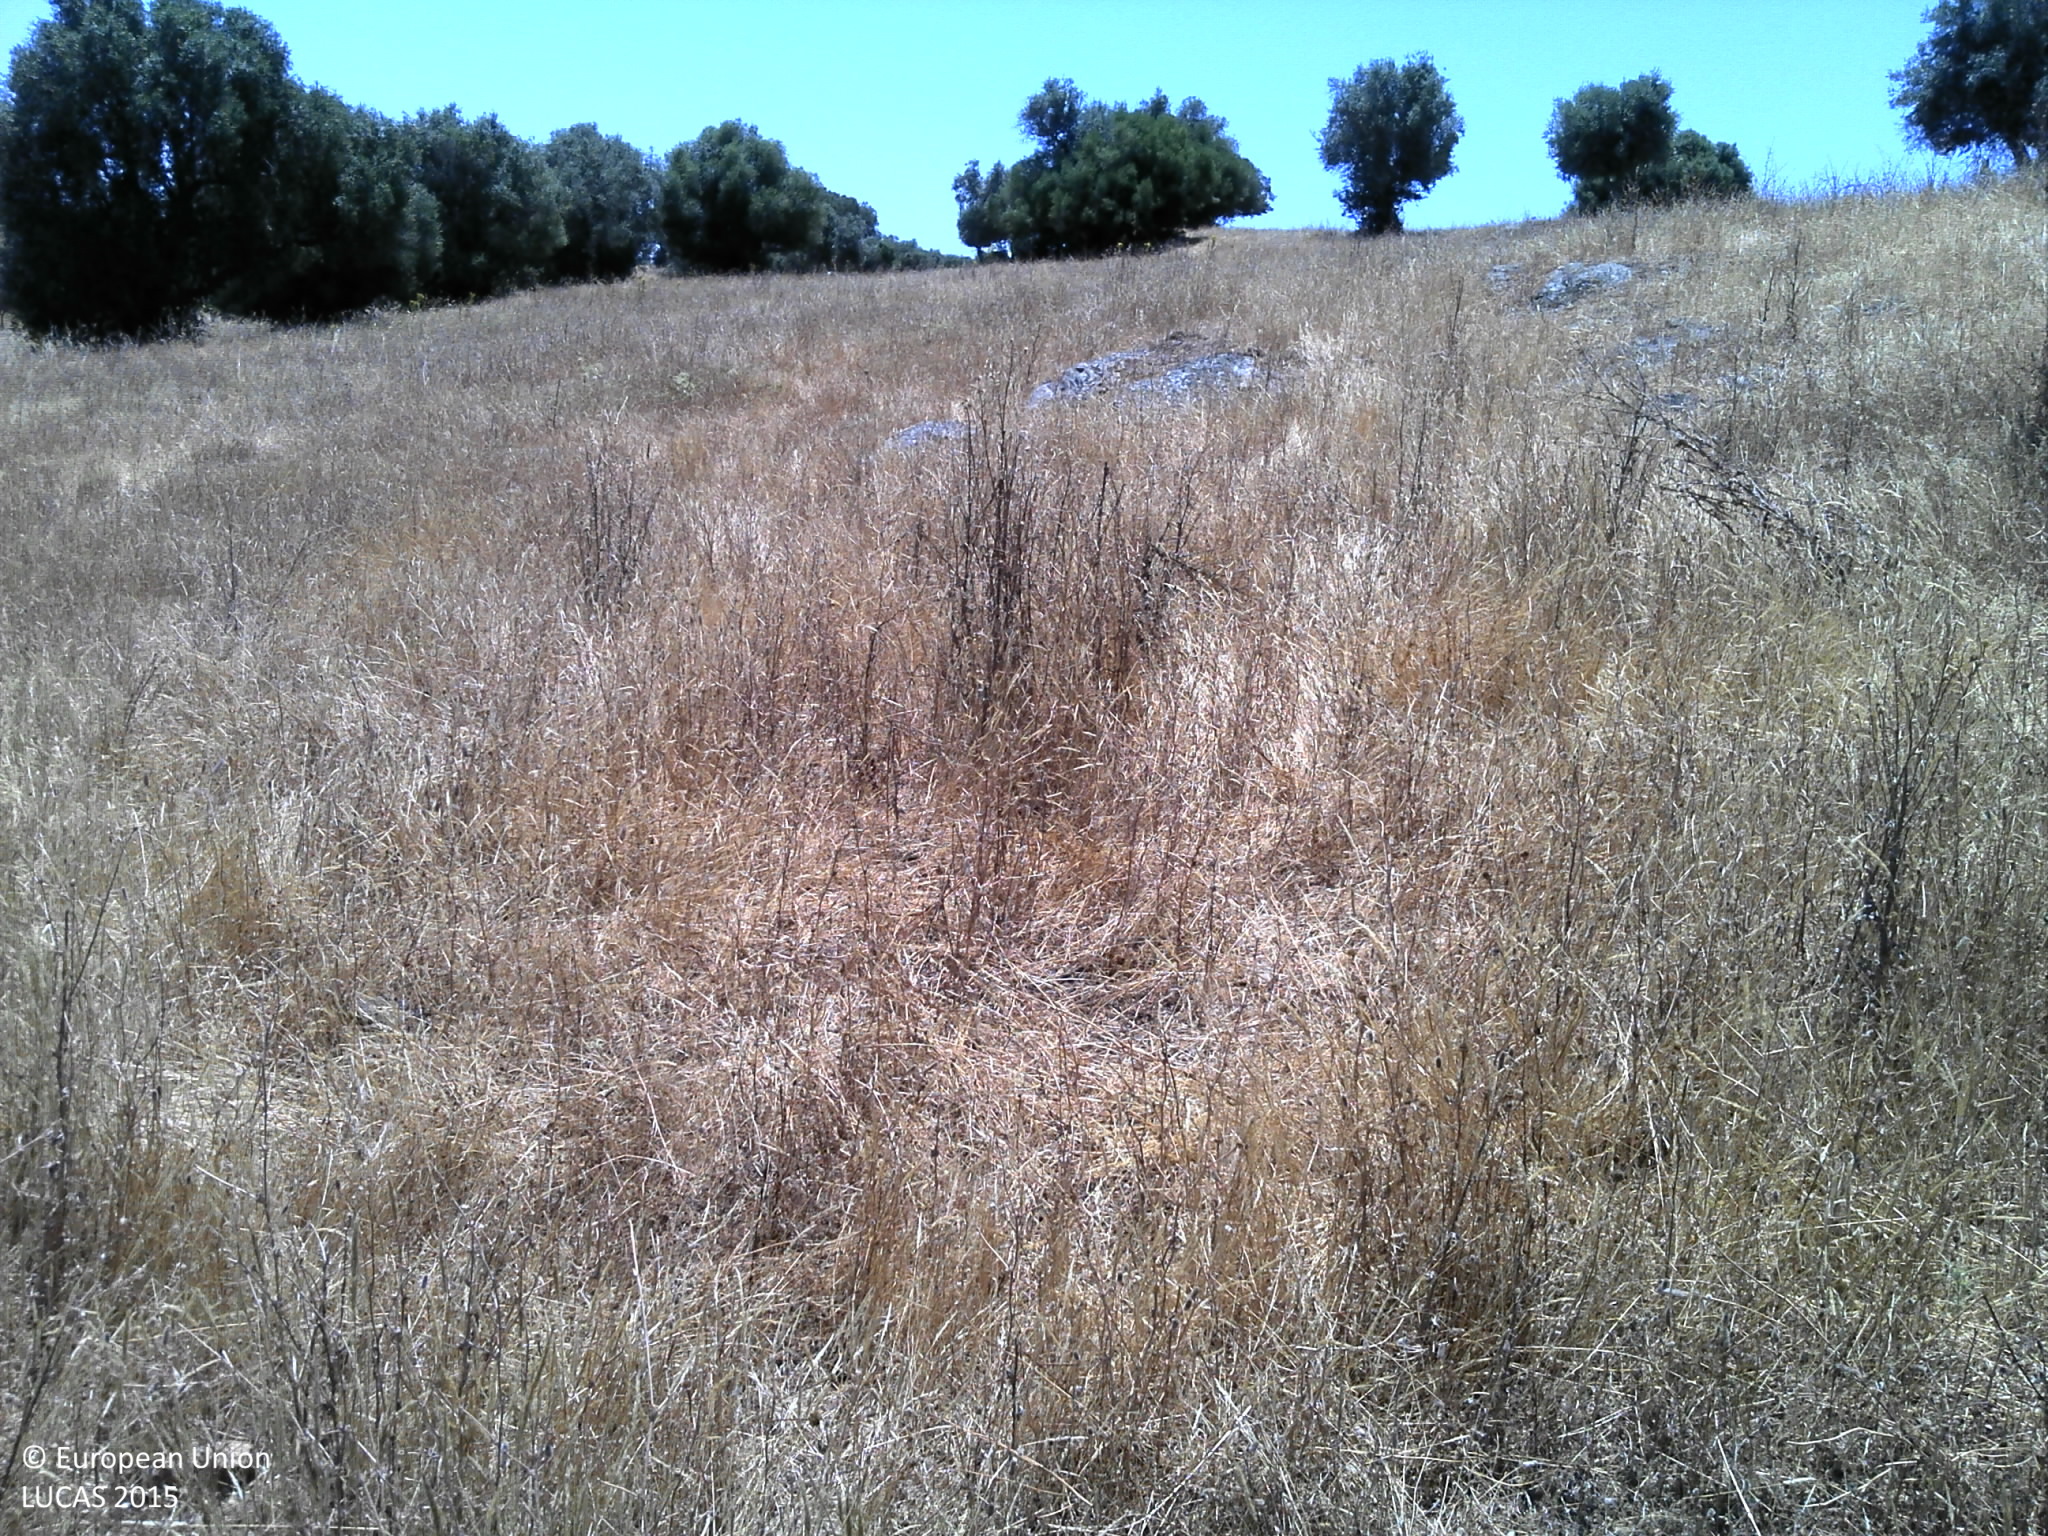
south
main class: Grassland
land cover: Grassland with sparse tree/shrub cover
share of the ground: 50 - 75 %
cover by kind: herbaceous plants 50 %, consolidated bare surface 45 %, broadleaved forest trees 5 %
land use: Agriculture (excluding fallow land and kitchen gardens)
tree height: > 5 m
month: July
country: PT
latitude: 37.7180
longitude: -8.2852
